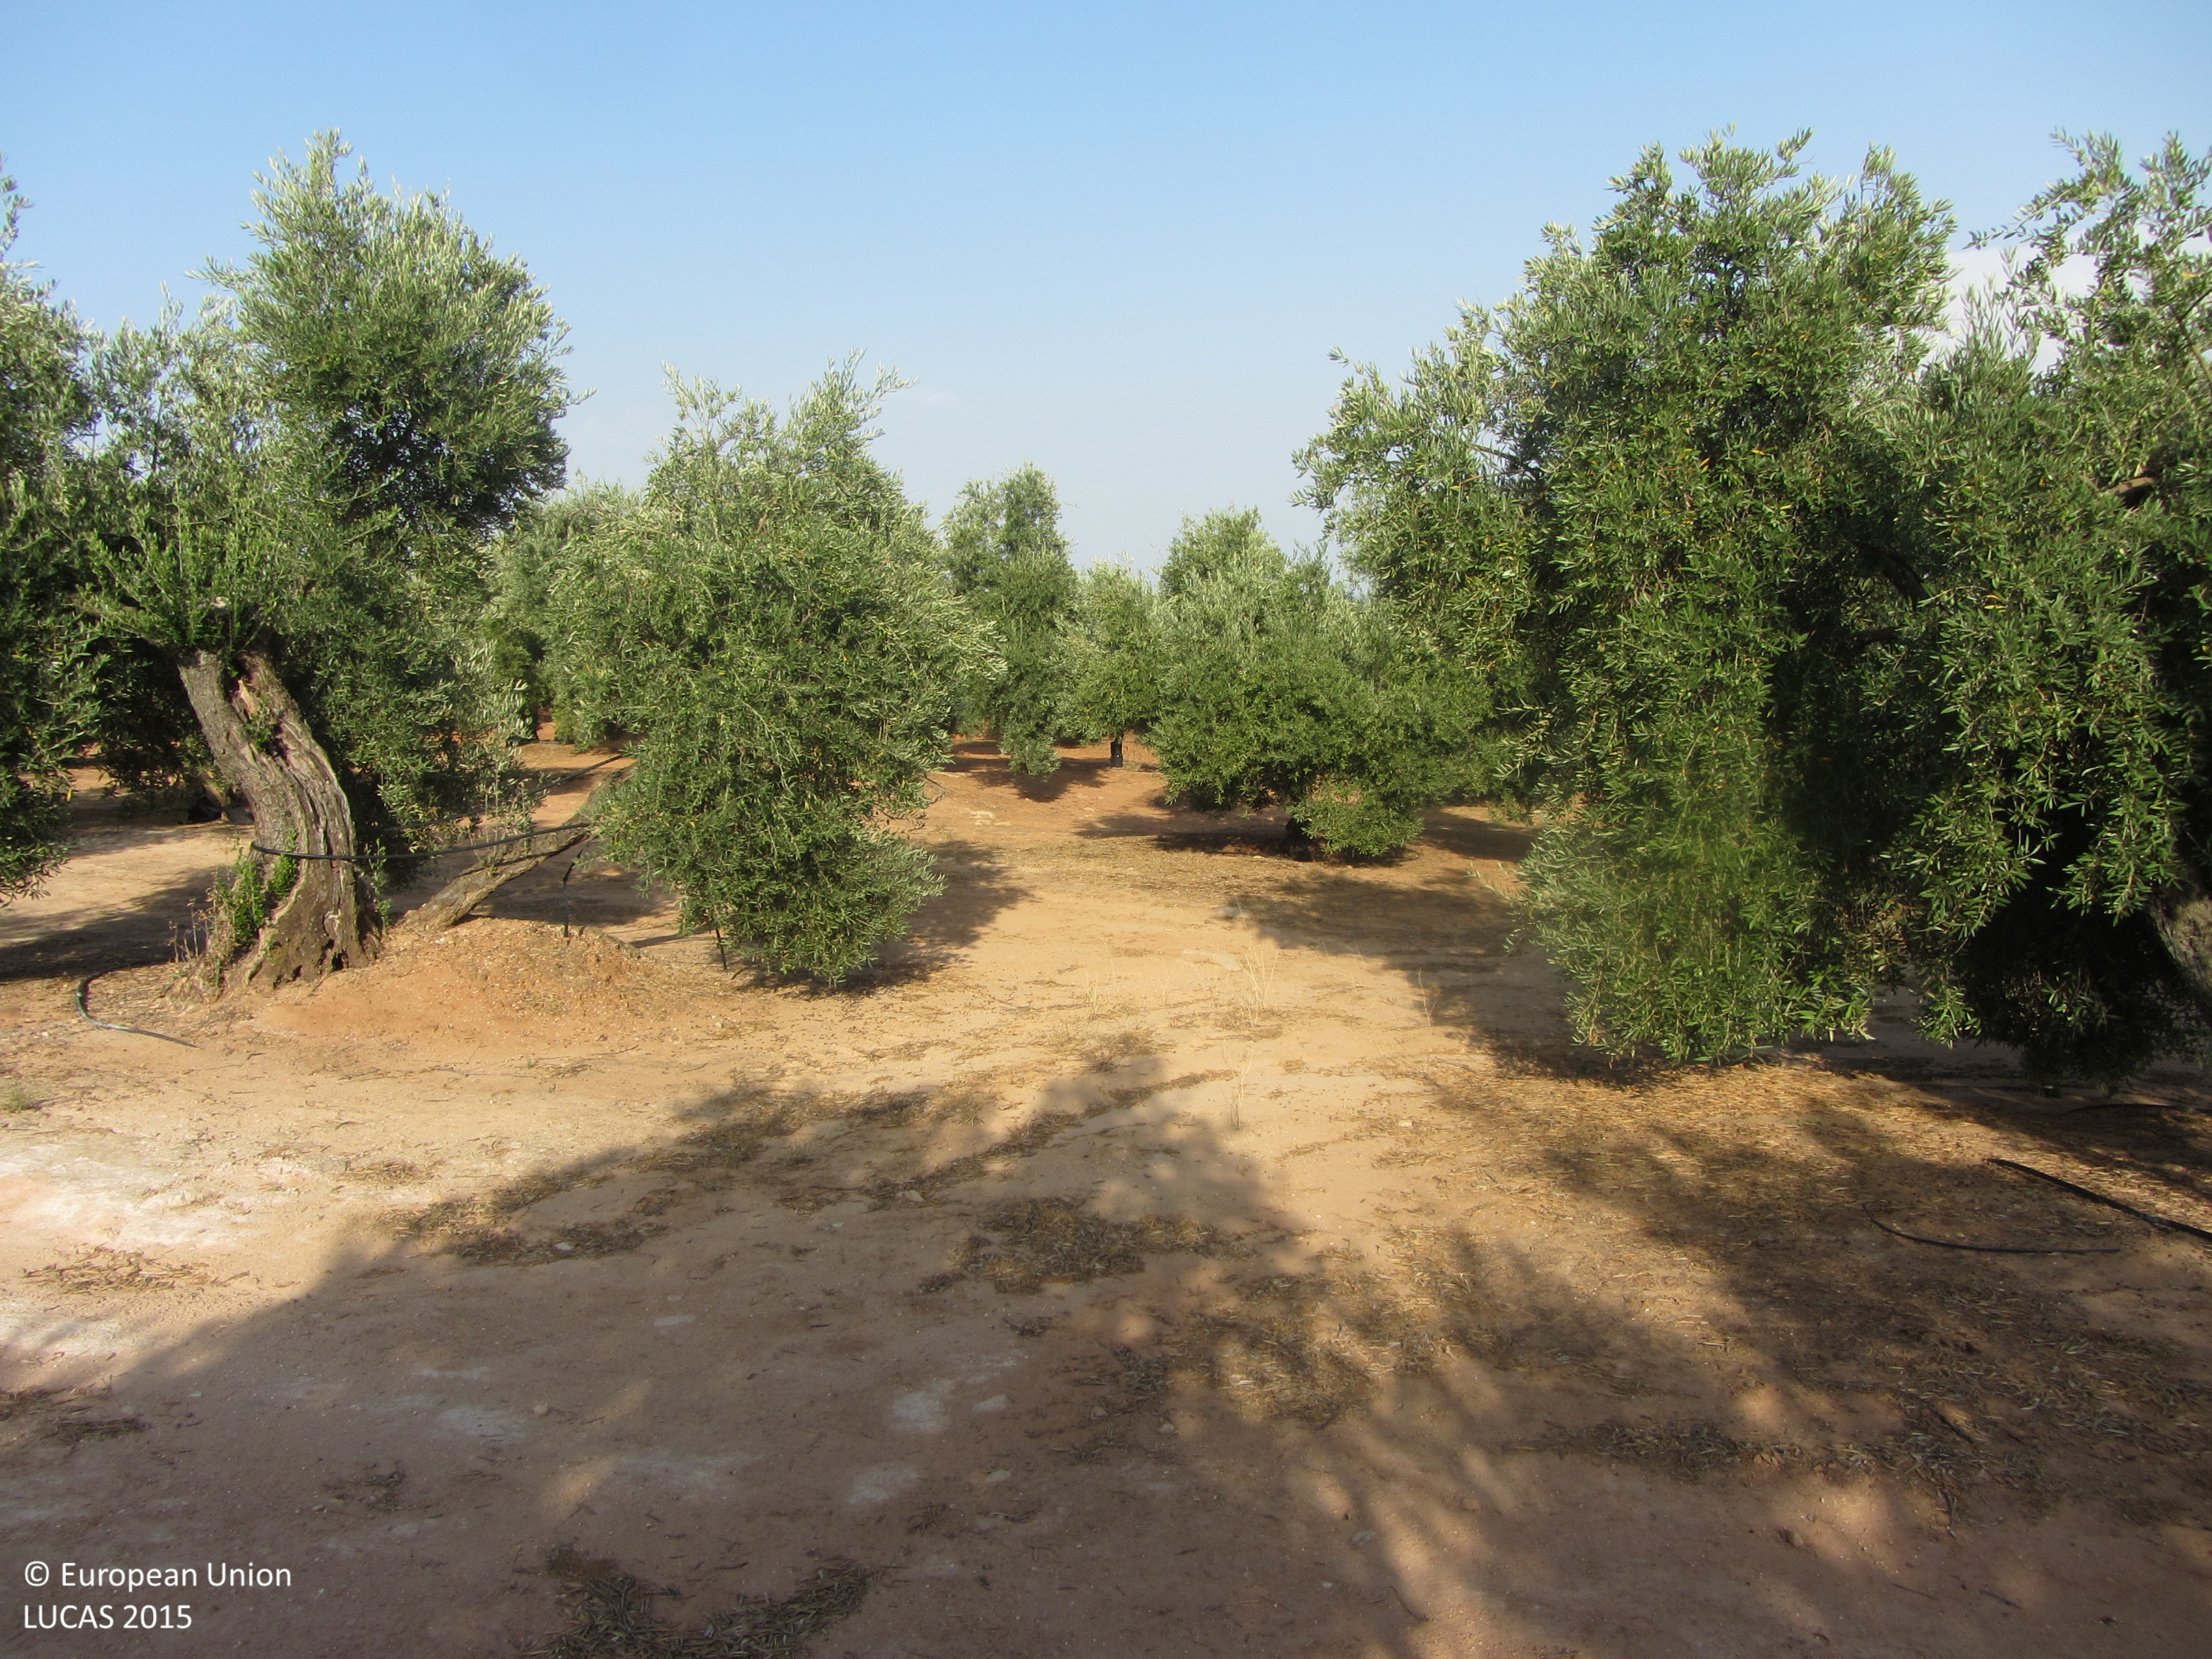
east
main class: Cropland
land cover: Olive groves
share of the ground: 25 - 50 %
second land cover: Other bare soil
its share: > 75 %
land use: Agriculture (excluding fallow land and kitchen gardens)
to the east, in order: Olive groves; Other bare soil; Electric lines; Olive groves
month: July
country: ES
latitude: 38.0652
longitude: -3.8776
